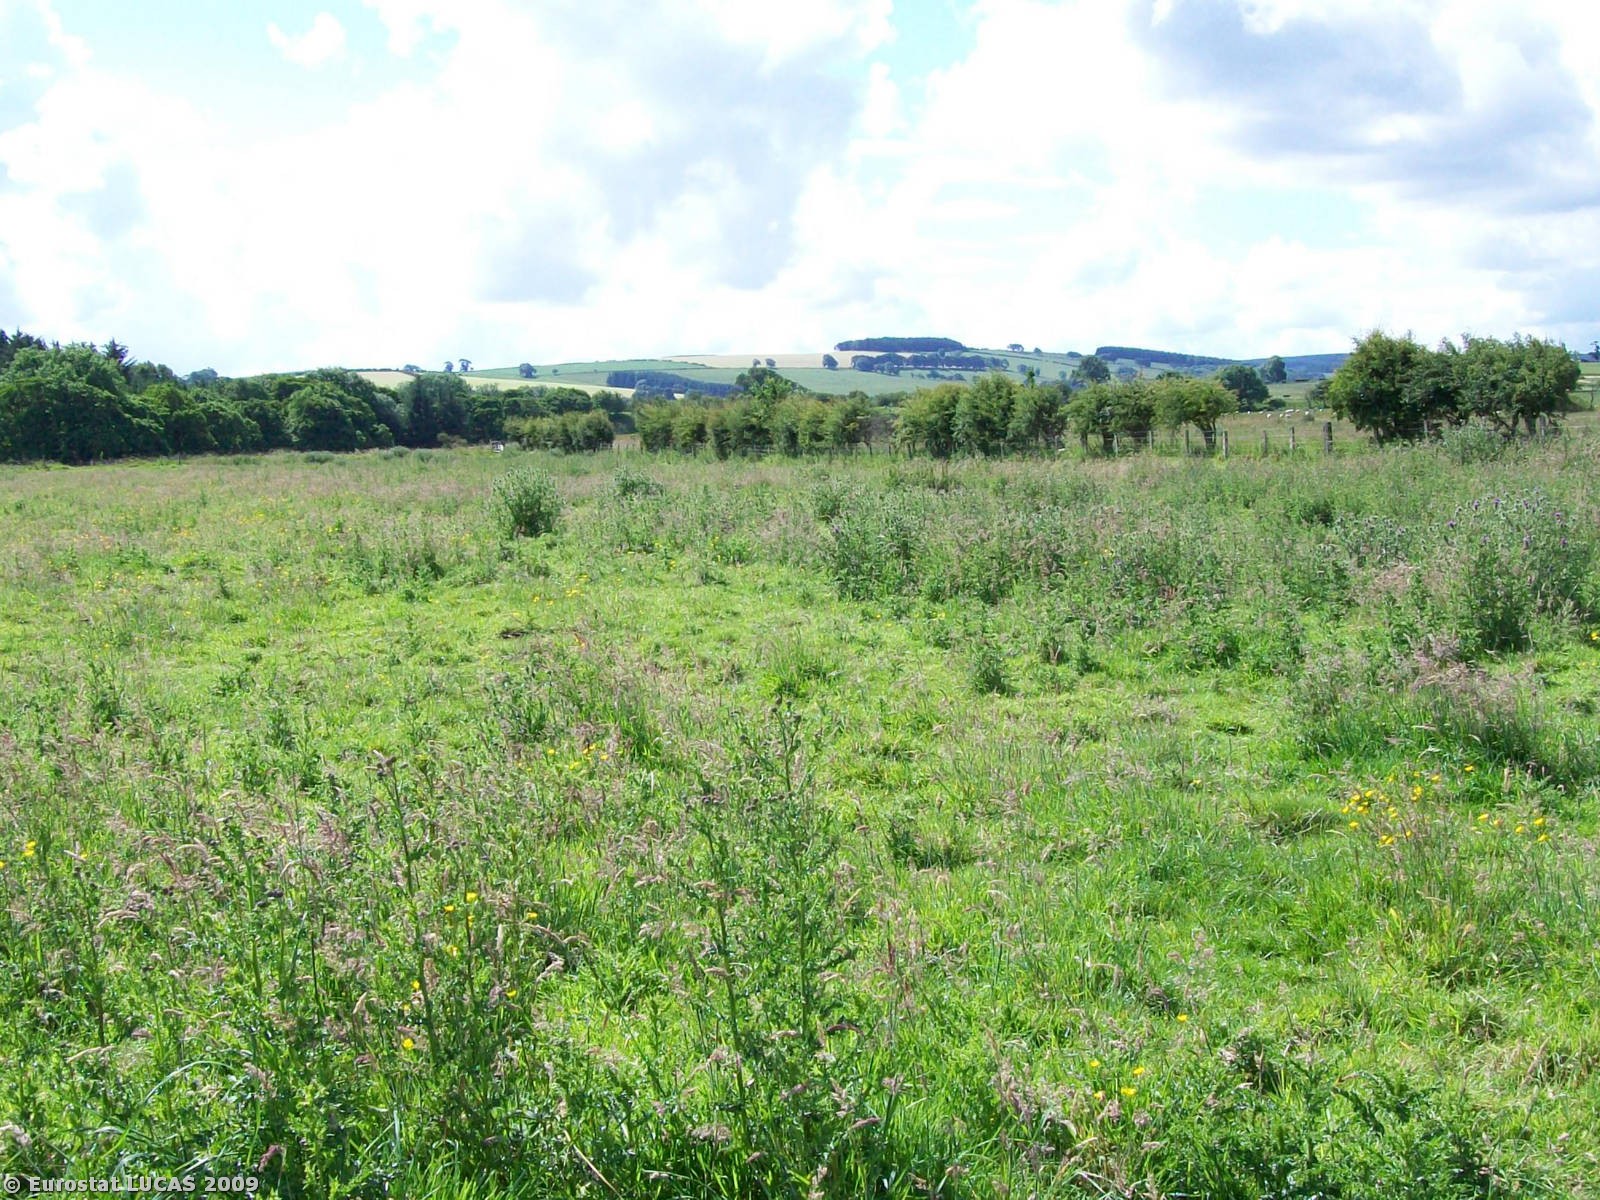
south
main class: Grassland
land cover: Grassland without tree/shrub cover
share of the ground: > 75 %
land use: Agriculture (excluding fallow land and kitchen gardens)
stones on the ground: < 10 %
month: July
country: GB
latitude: 55.4002
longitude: -1.8468
